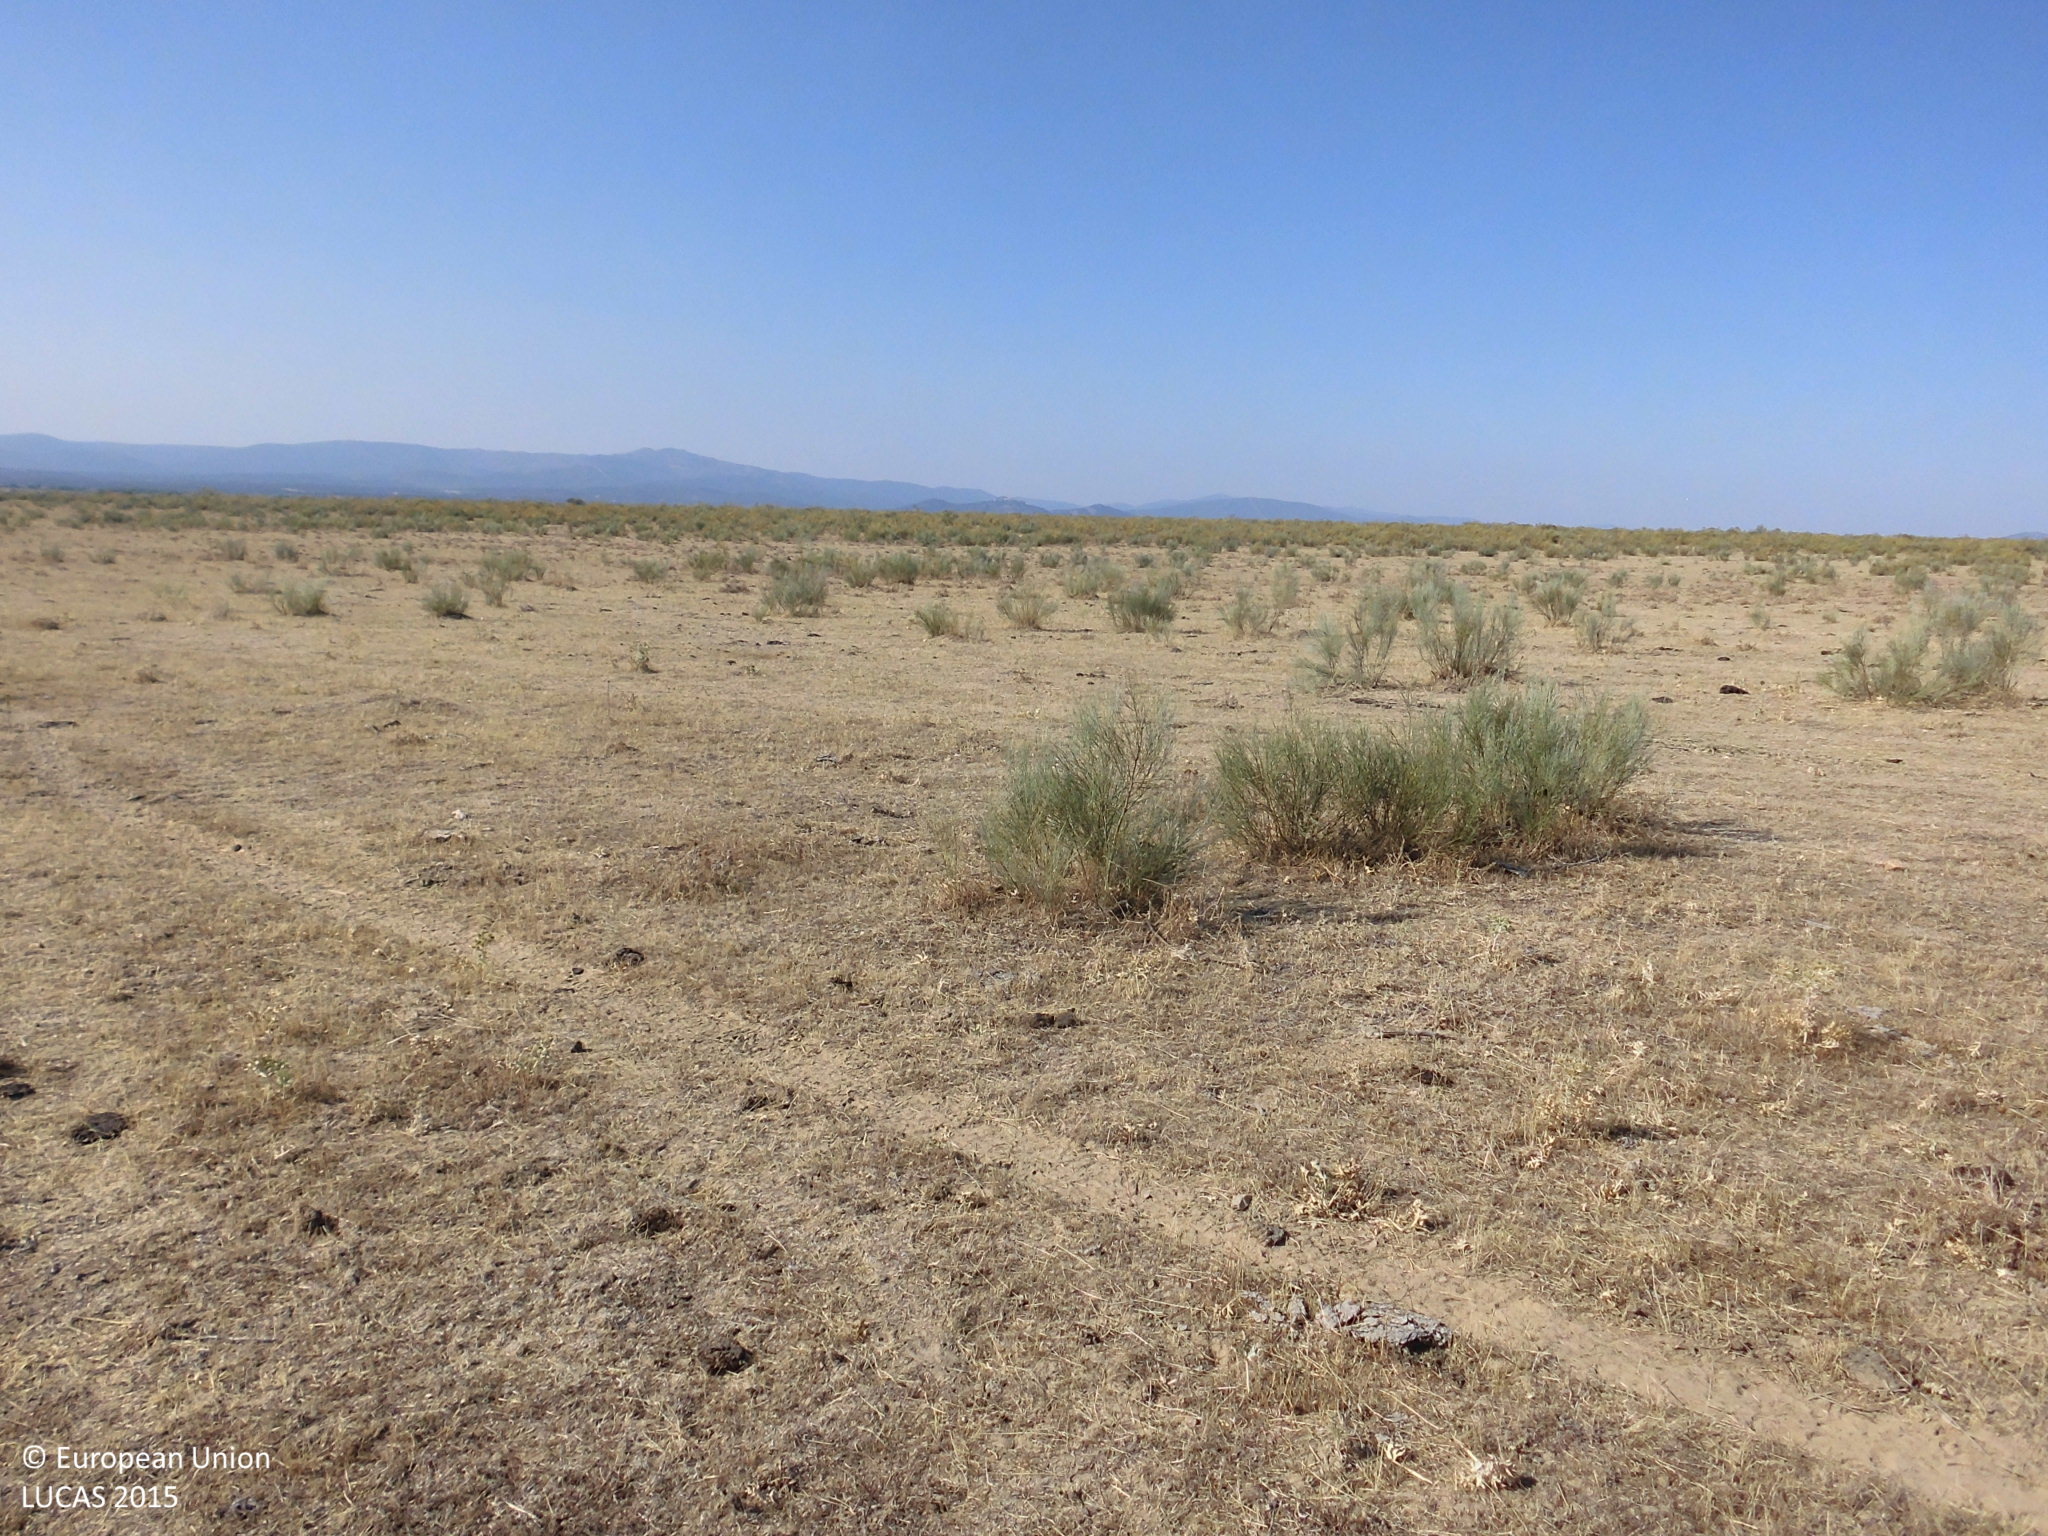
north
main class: Grassland
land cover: Grassland without tree/shrub cover
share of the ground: > 75 %
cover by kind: herbaceous plants 100 %
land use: Agriculture (excluding fallow land and kitchen gardens)
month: July
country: ES
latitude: 40.0403
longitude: -6.5959
